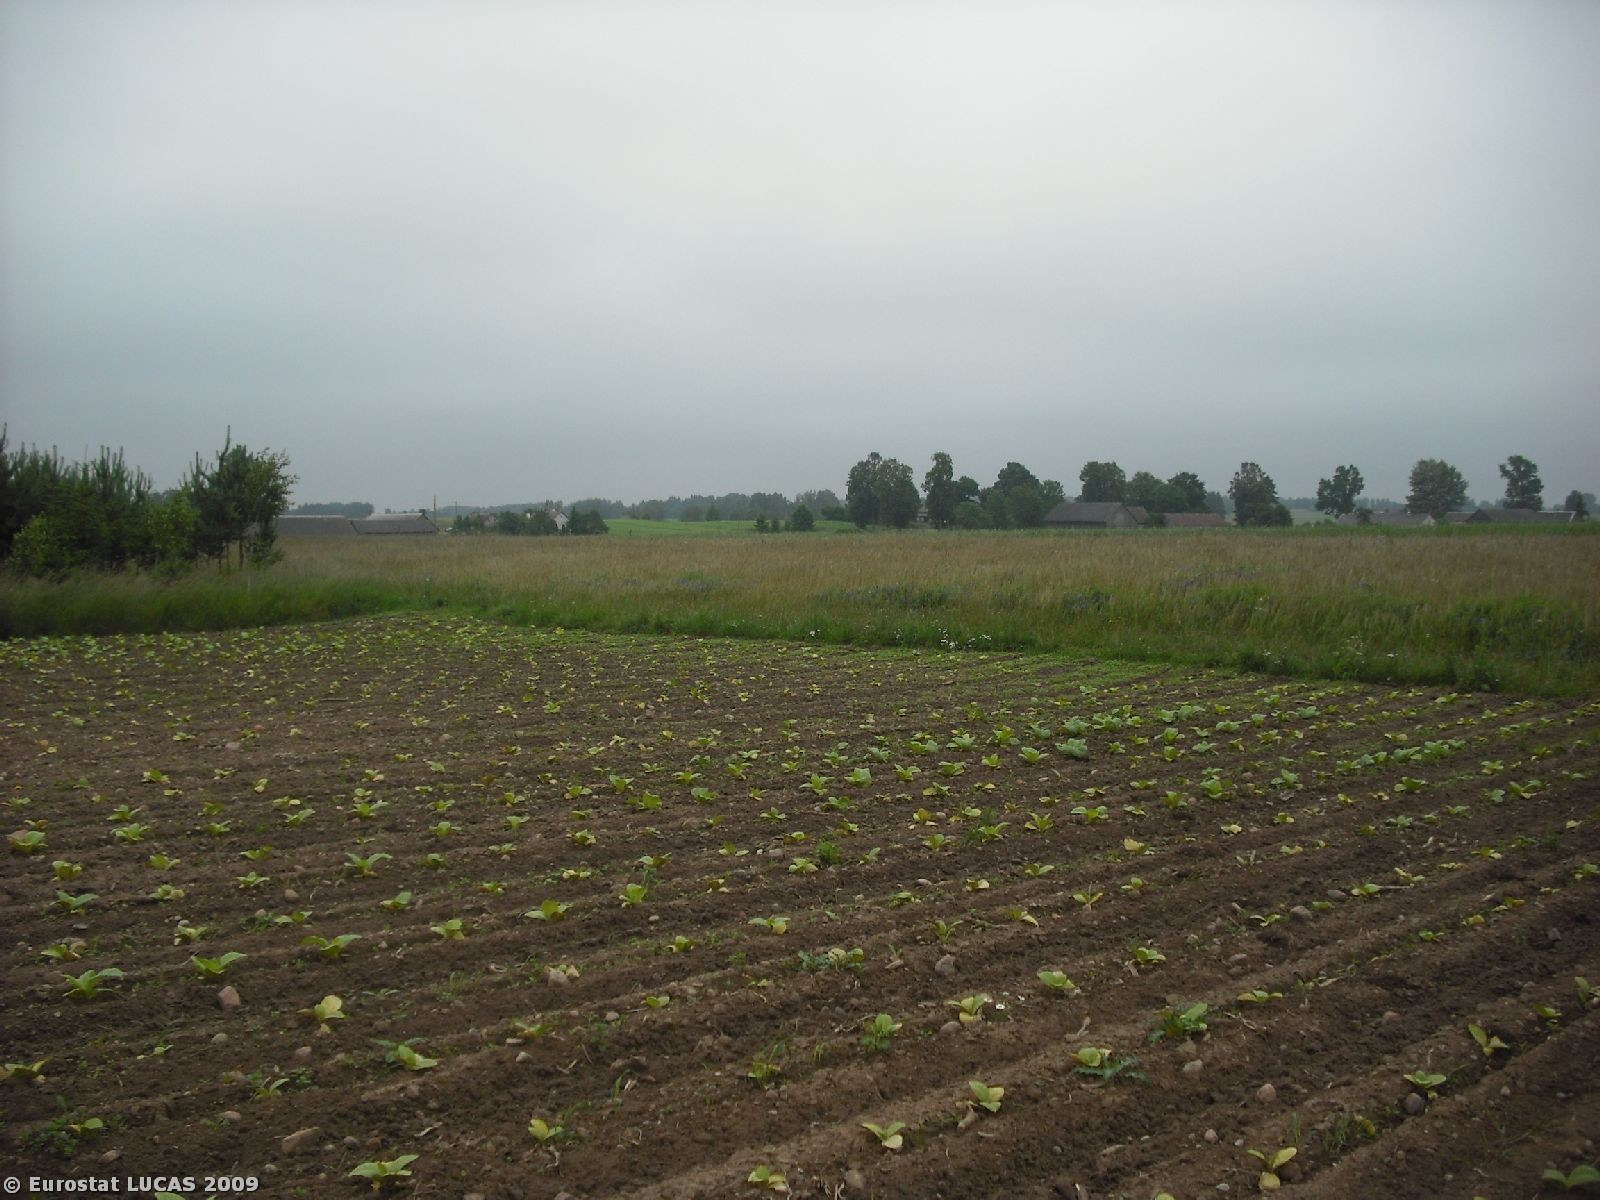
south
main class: Cropland
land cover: Tobacco
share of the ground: 25 - 50 %
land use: Agriculture (excluding fallow land and kitchen gardens)
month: June
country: PL
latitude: 53.9791
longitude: 22.7710
